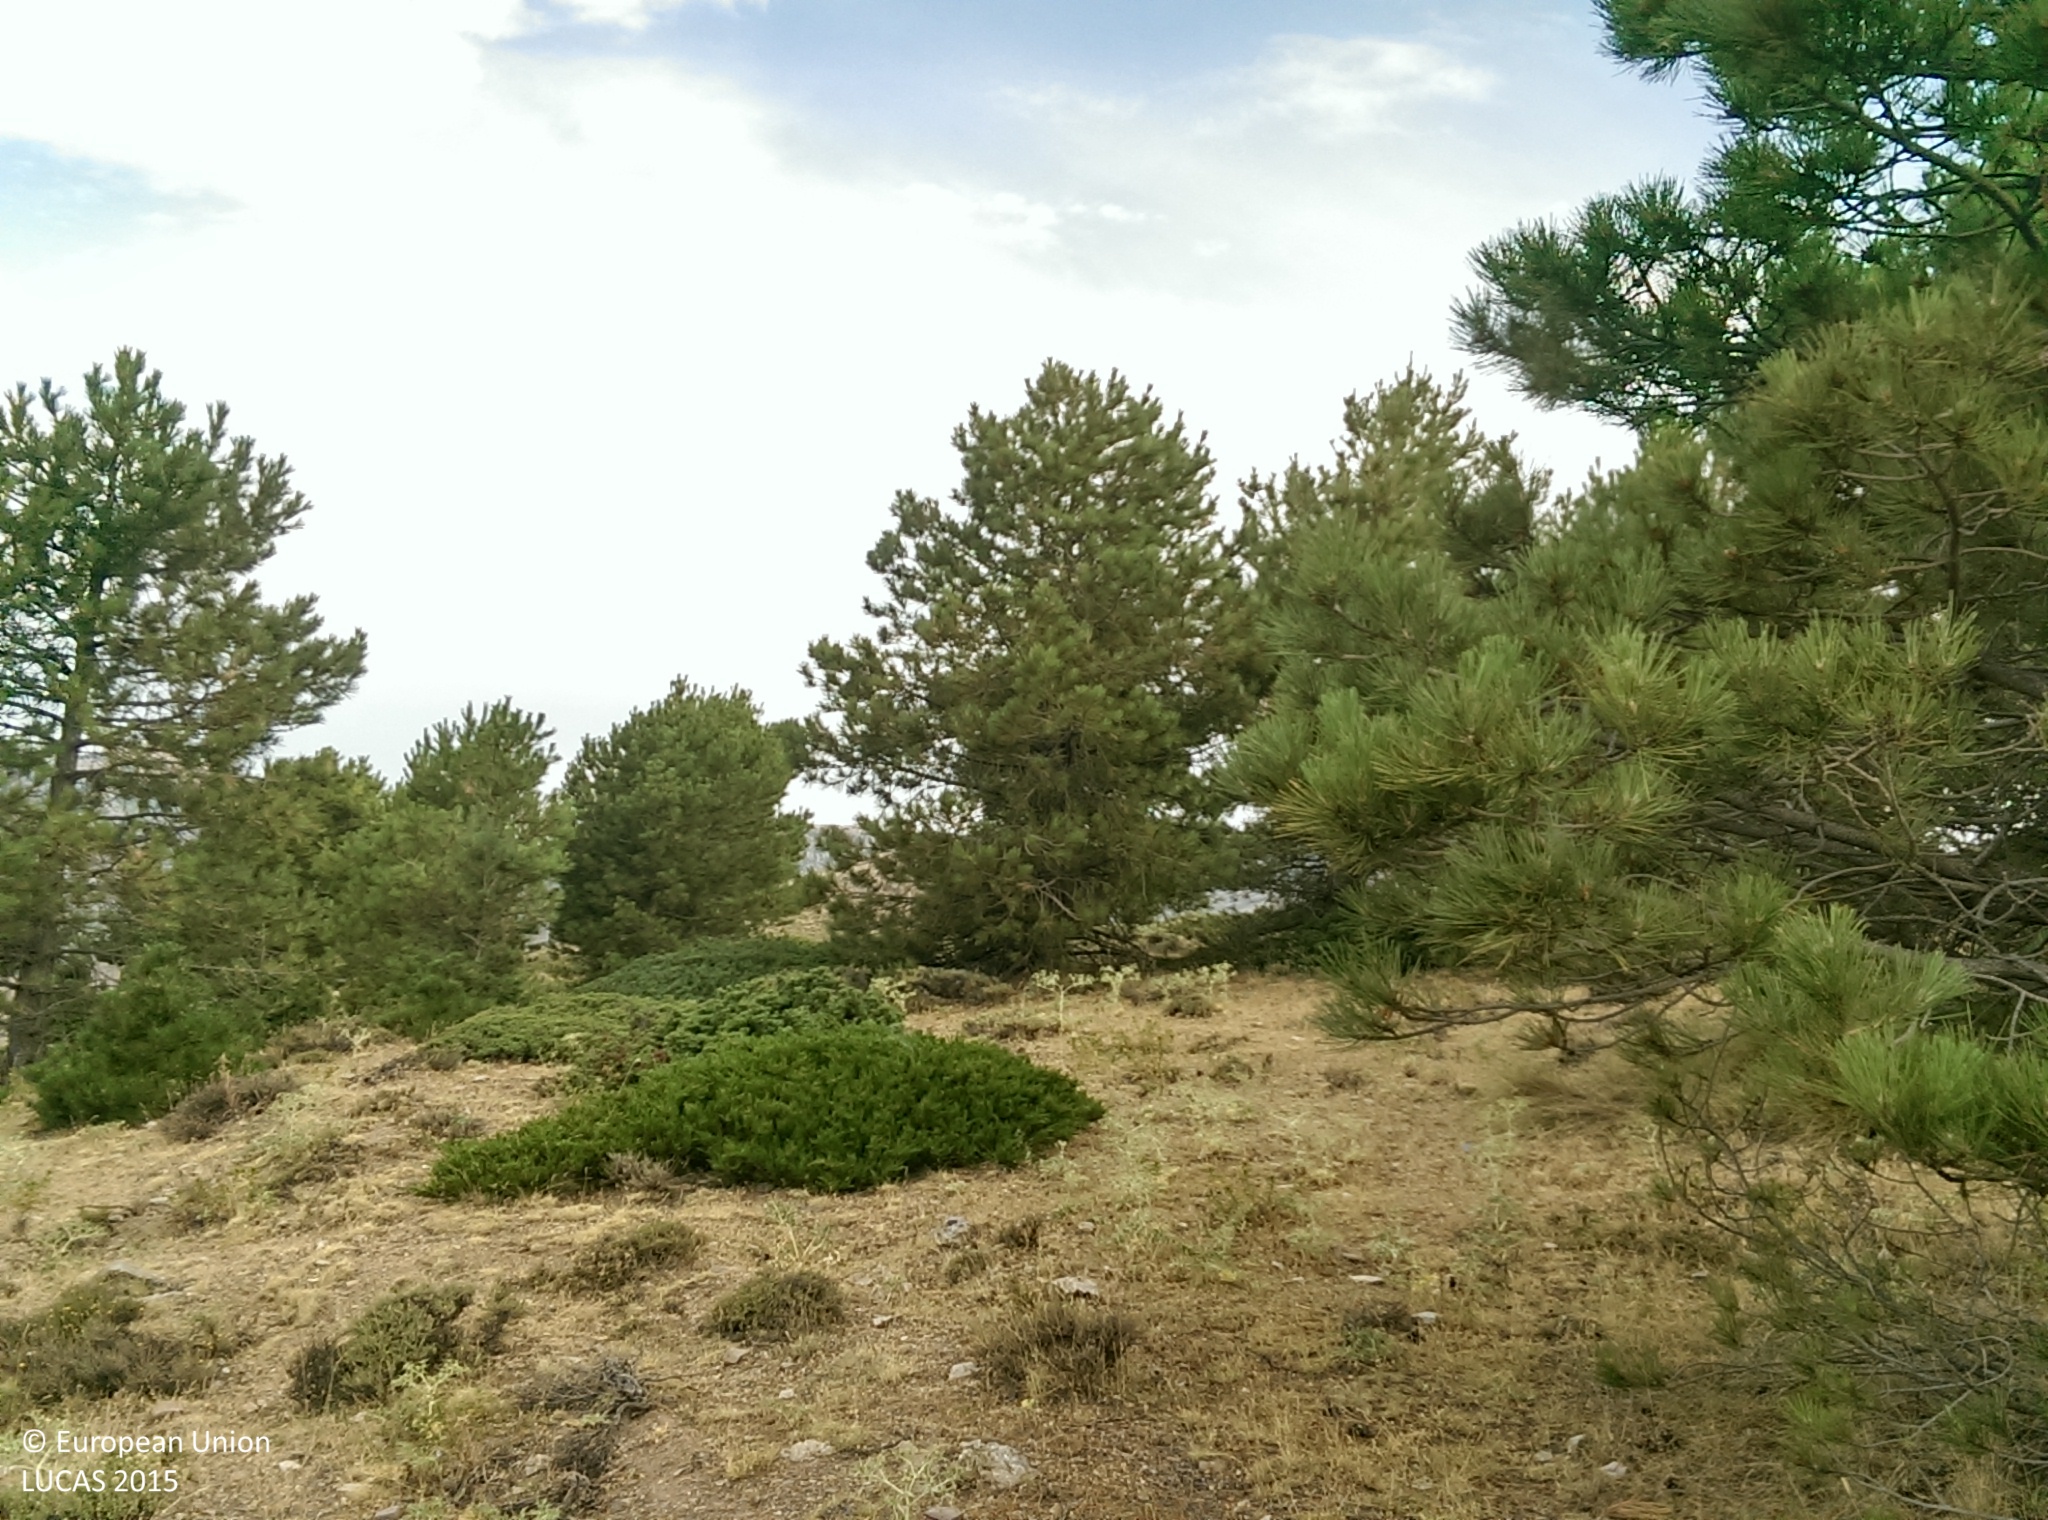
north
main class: Woodland
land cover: Pine dominated coniferous woodland
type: alpine coniferous forest
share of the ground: > 75 %
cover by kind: coniferous forest trees 80 %, shrubs 5 %, herbaceous plants 5 %, consolidated bare surface 5 %, unconsolidated bare surface 5 %
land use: Forestry
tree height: > 5 m
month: July
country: ES
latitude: 37.3286
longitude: -2.8624
